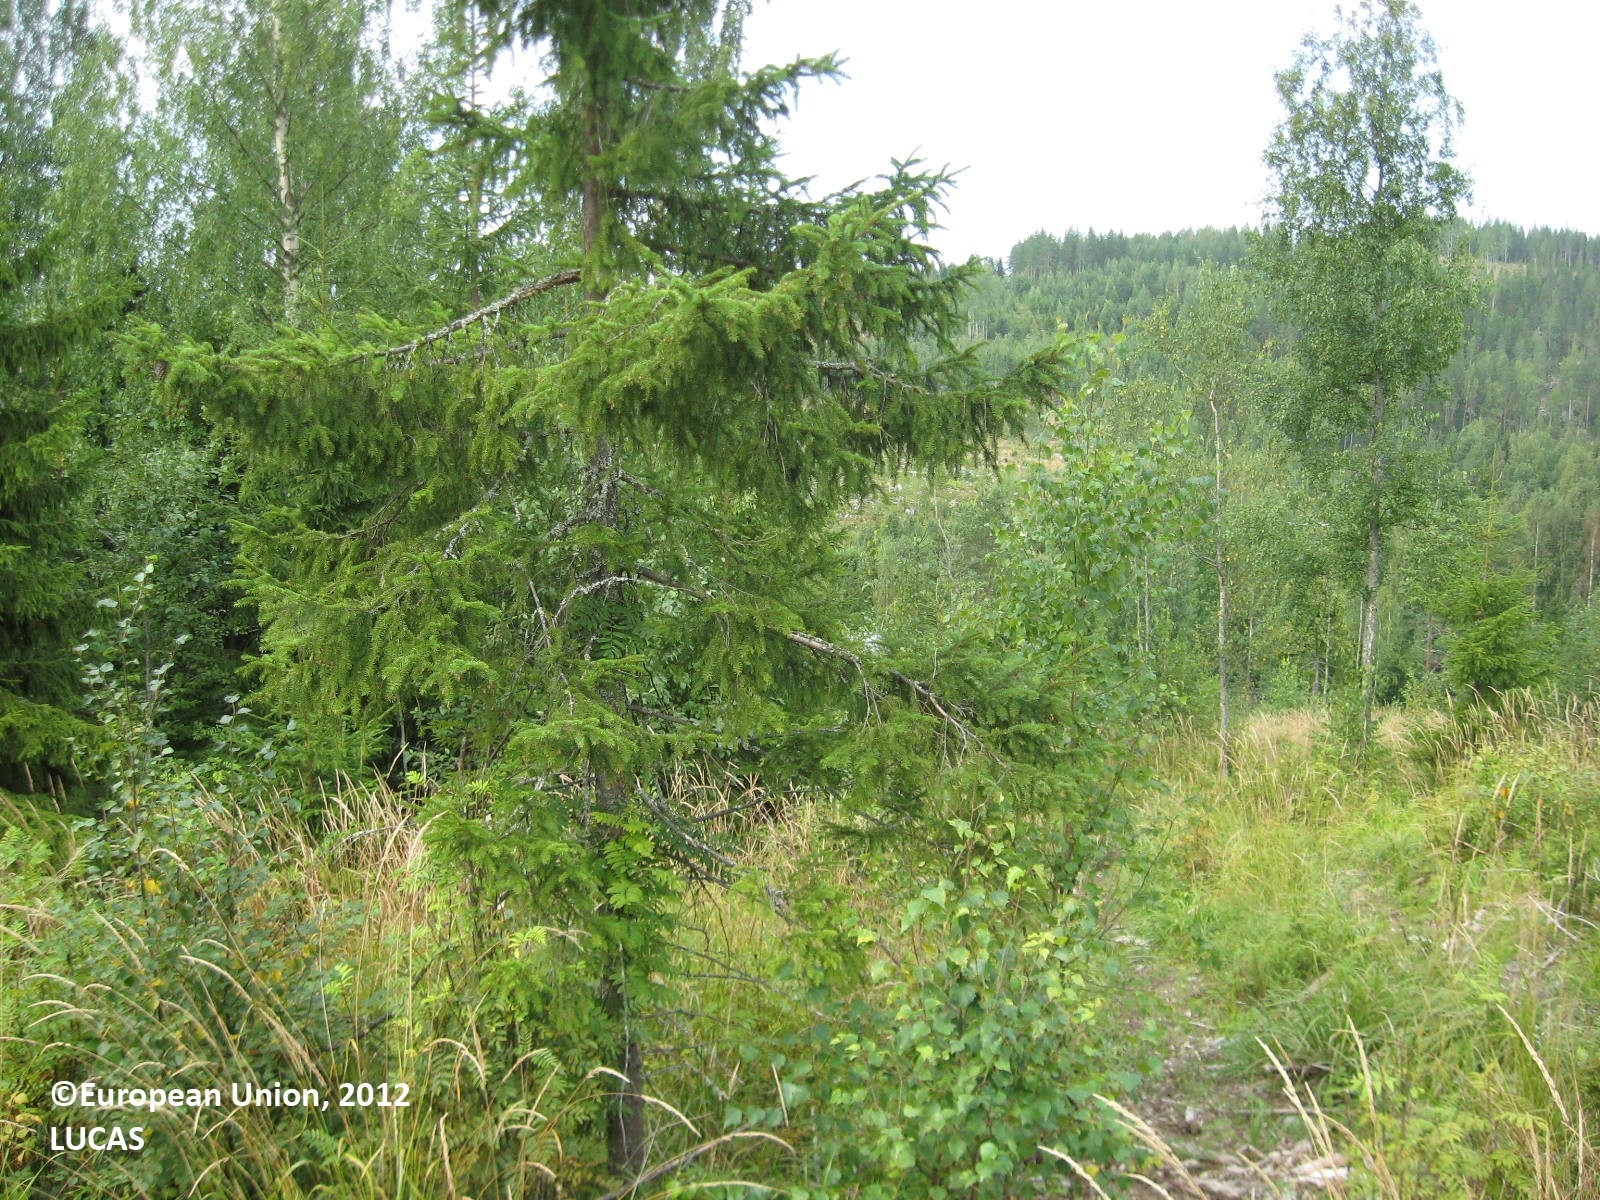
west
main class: Woodland
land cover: Other mixed woodland
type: boreal forest
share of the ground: 50 - 75 %
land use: Forestry
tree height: < 5 m
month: August
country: FI
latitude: 63.4439
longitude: 29.5361
